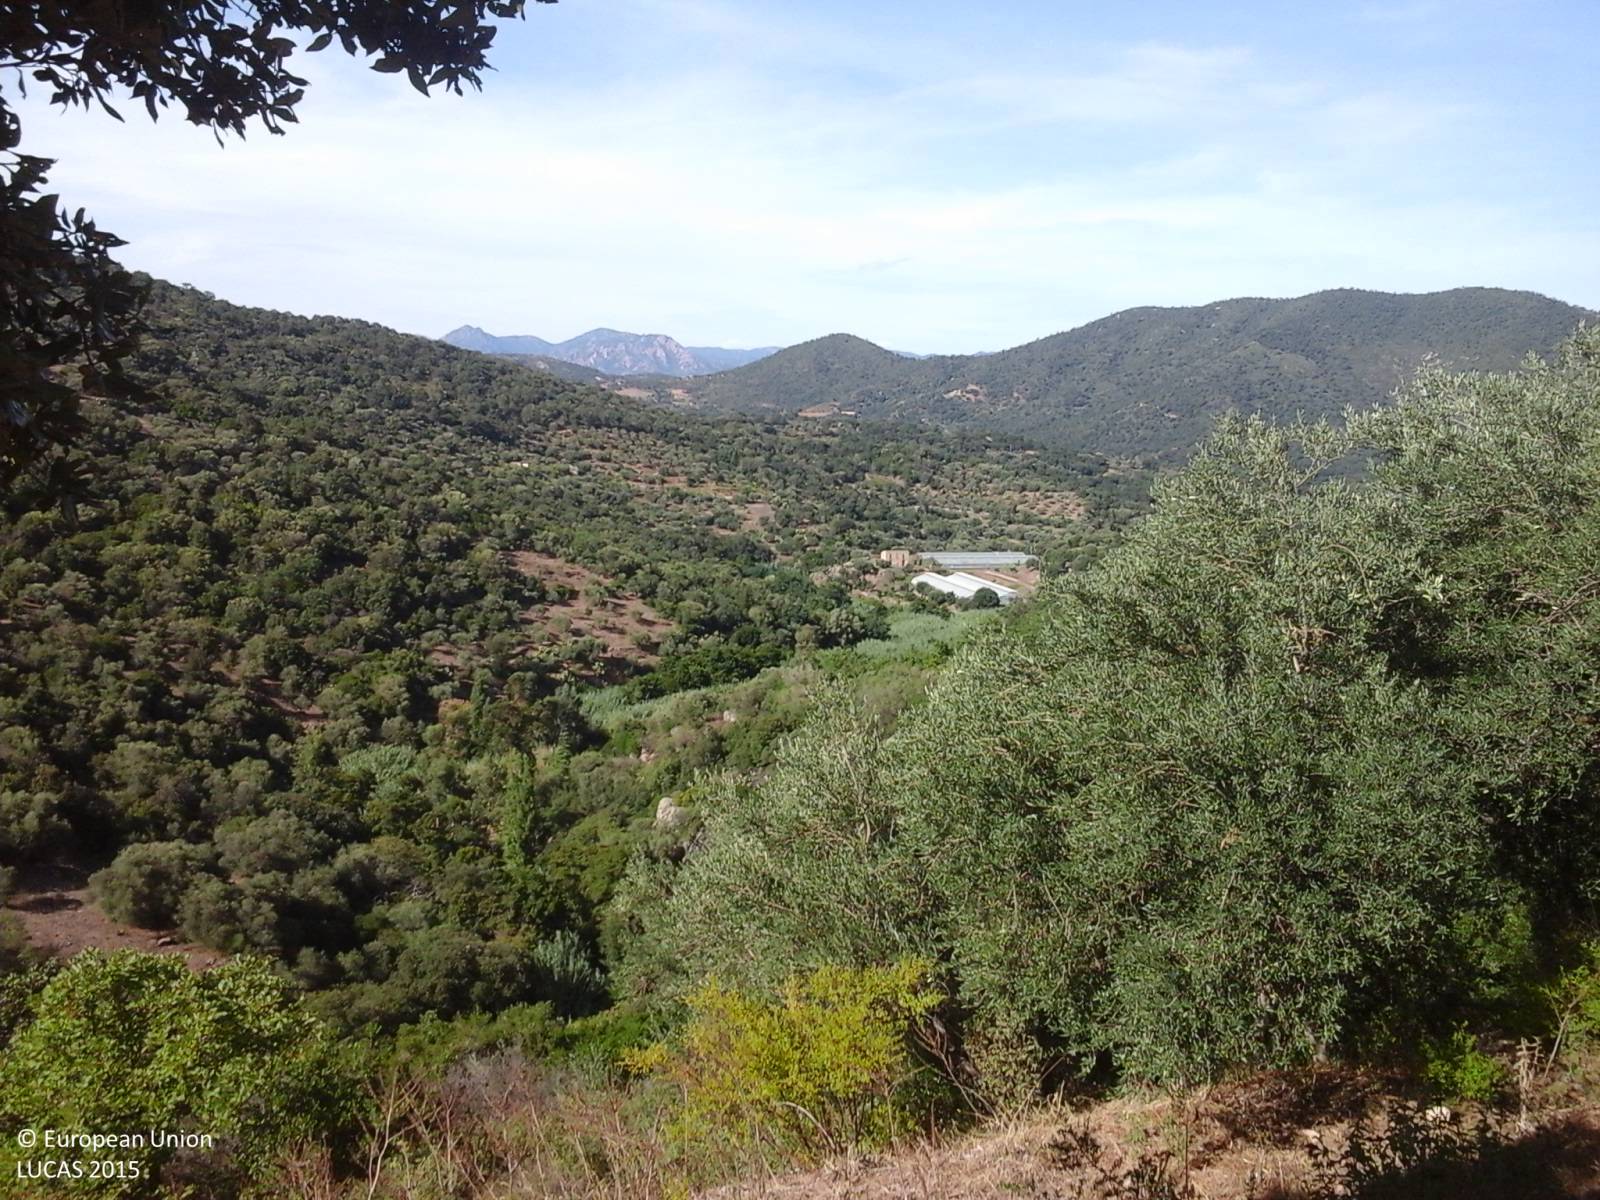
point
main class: Woodland
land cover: Broadleaved woodland
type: broadleaved evergreen forest
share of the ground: > 75 %
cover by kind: broadleaved forest trees 75 %, unconsolidated bare surface 15 %, shrubs 5 %, herbaceous plants 5 %
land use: Semi-natural and natural areas not in use
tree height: > 5 m
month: September
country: IT
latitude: 39.9043
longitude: 9.5696
